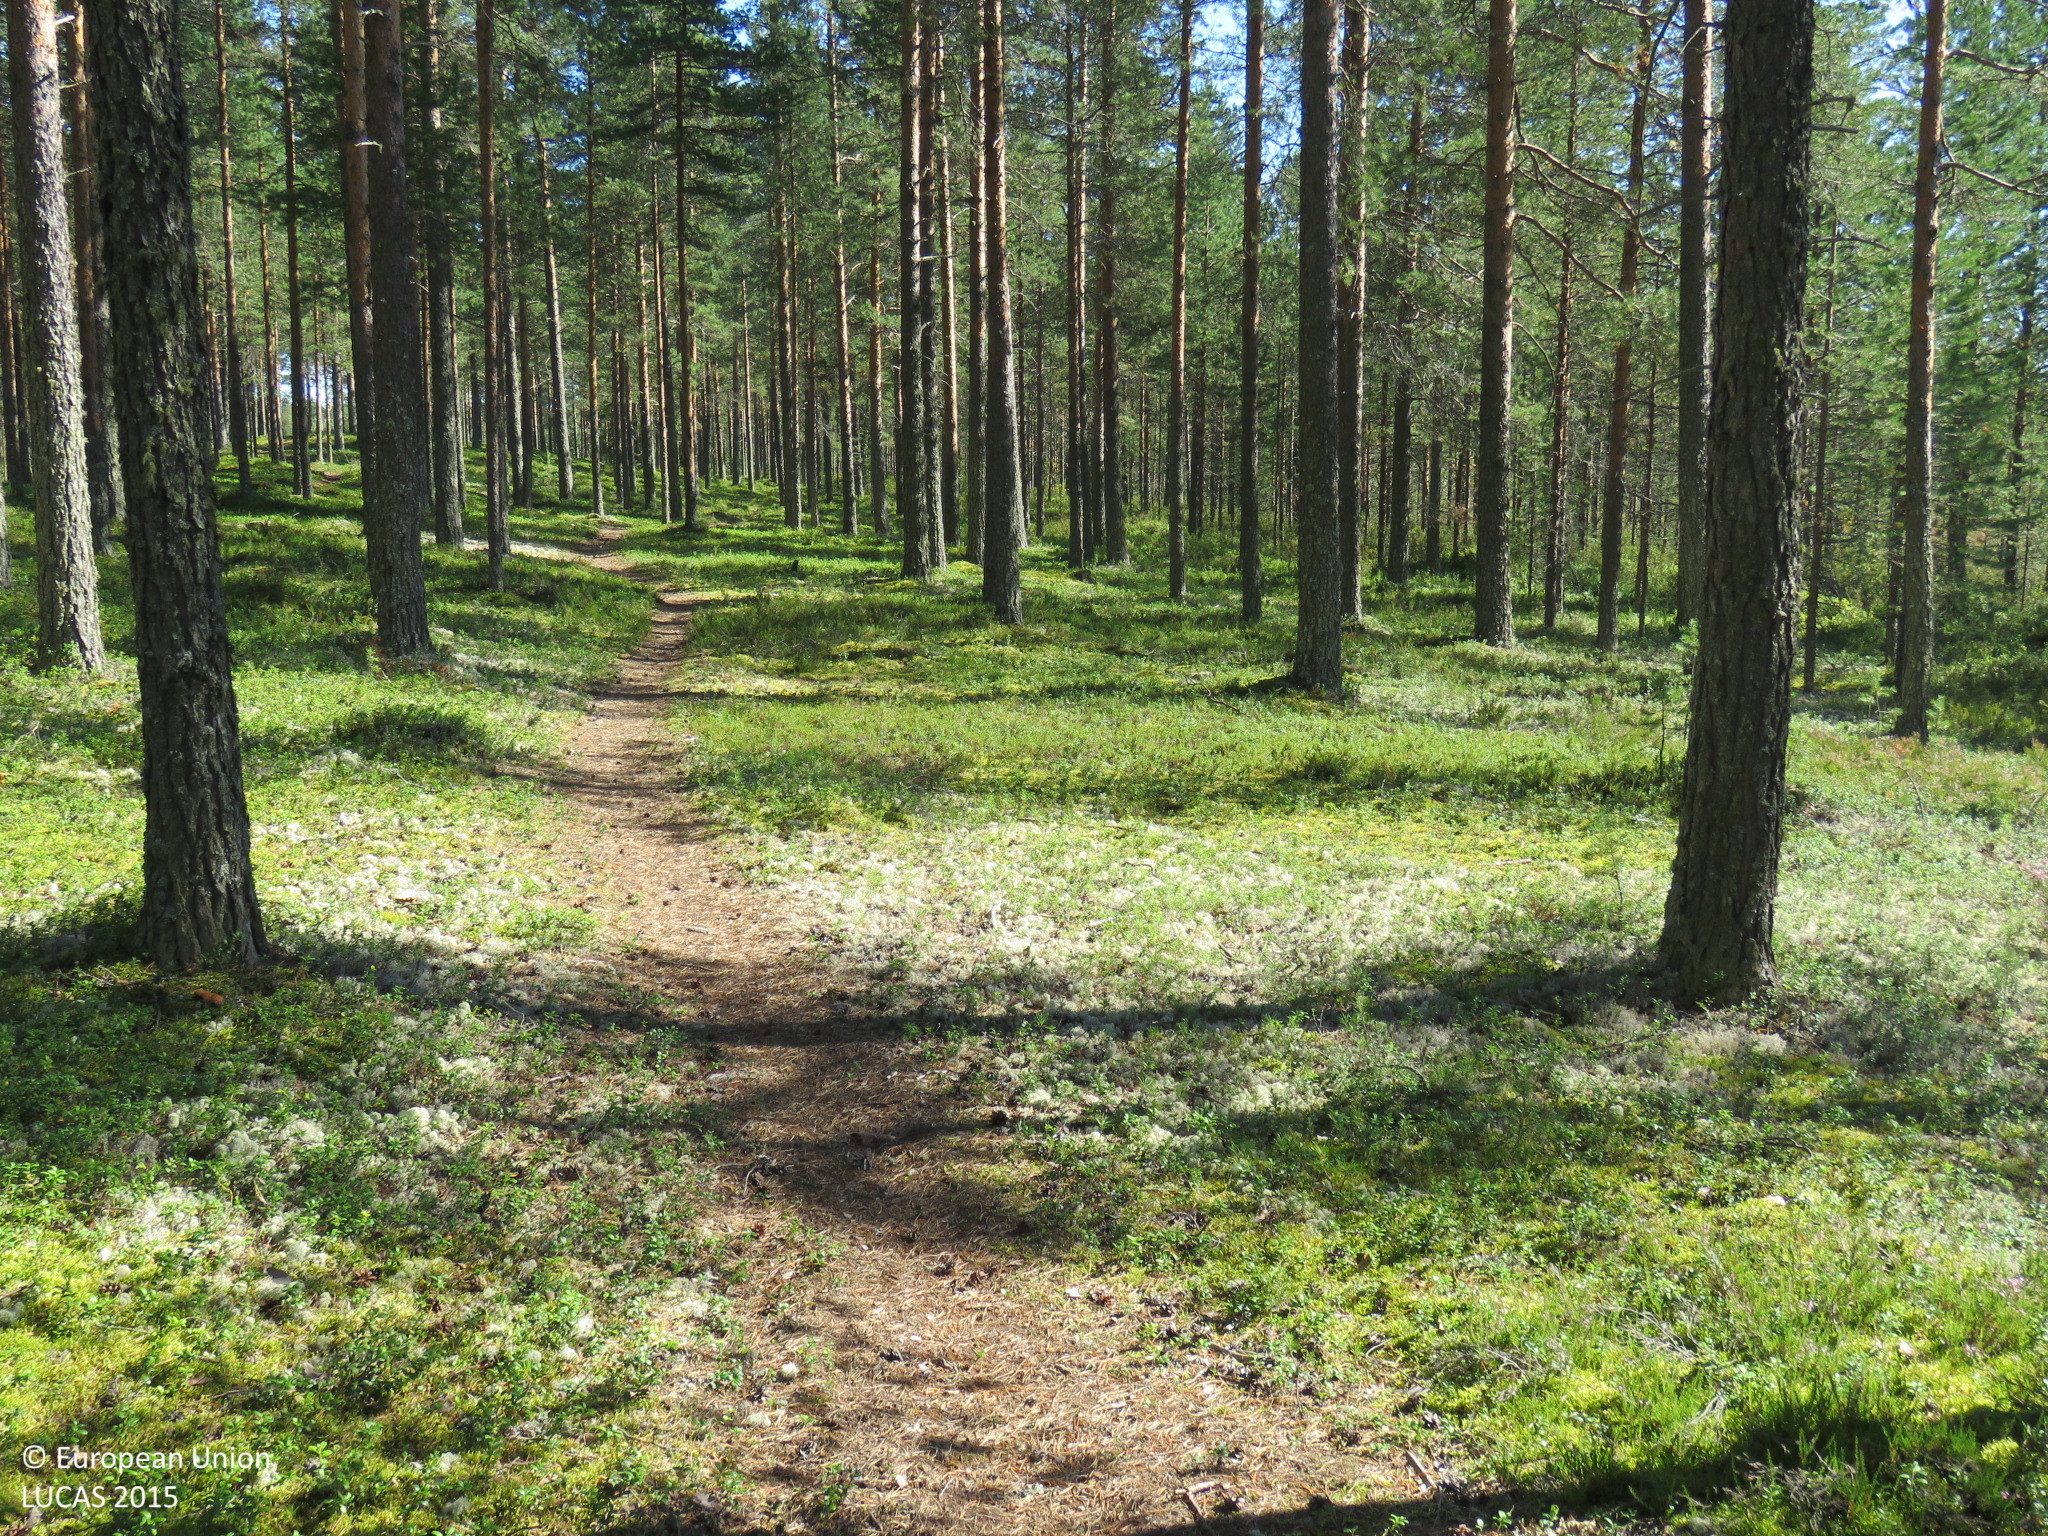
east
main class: Woodland
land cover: Pine dominated coniferous woodland
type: boreal forest
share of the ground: > 75 %
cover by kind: coniferous forest trees 75 %, shrubs 10 %, lichens and mosses 10 %, unconsolidated bare surface 5 %
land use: Forestry
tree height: > 5 m
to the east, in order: Pine dominated coniferous woodland; Sand; Pine dominated mixed woodland
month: August
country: FI
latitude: 65.1130
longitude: 25.6537
